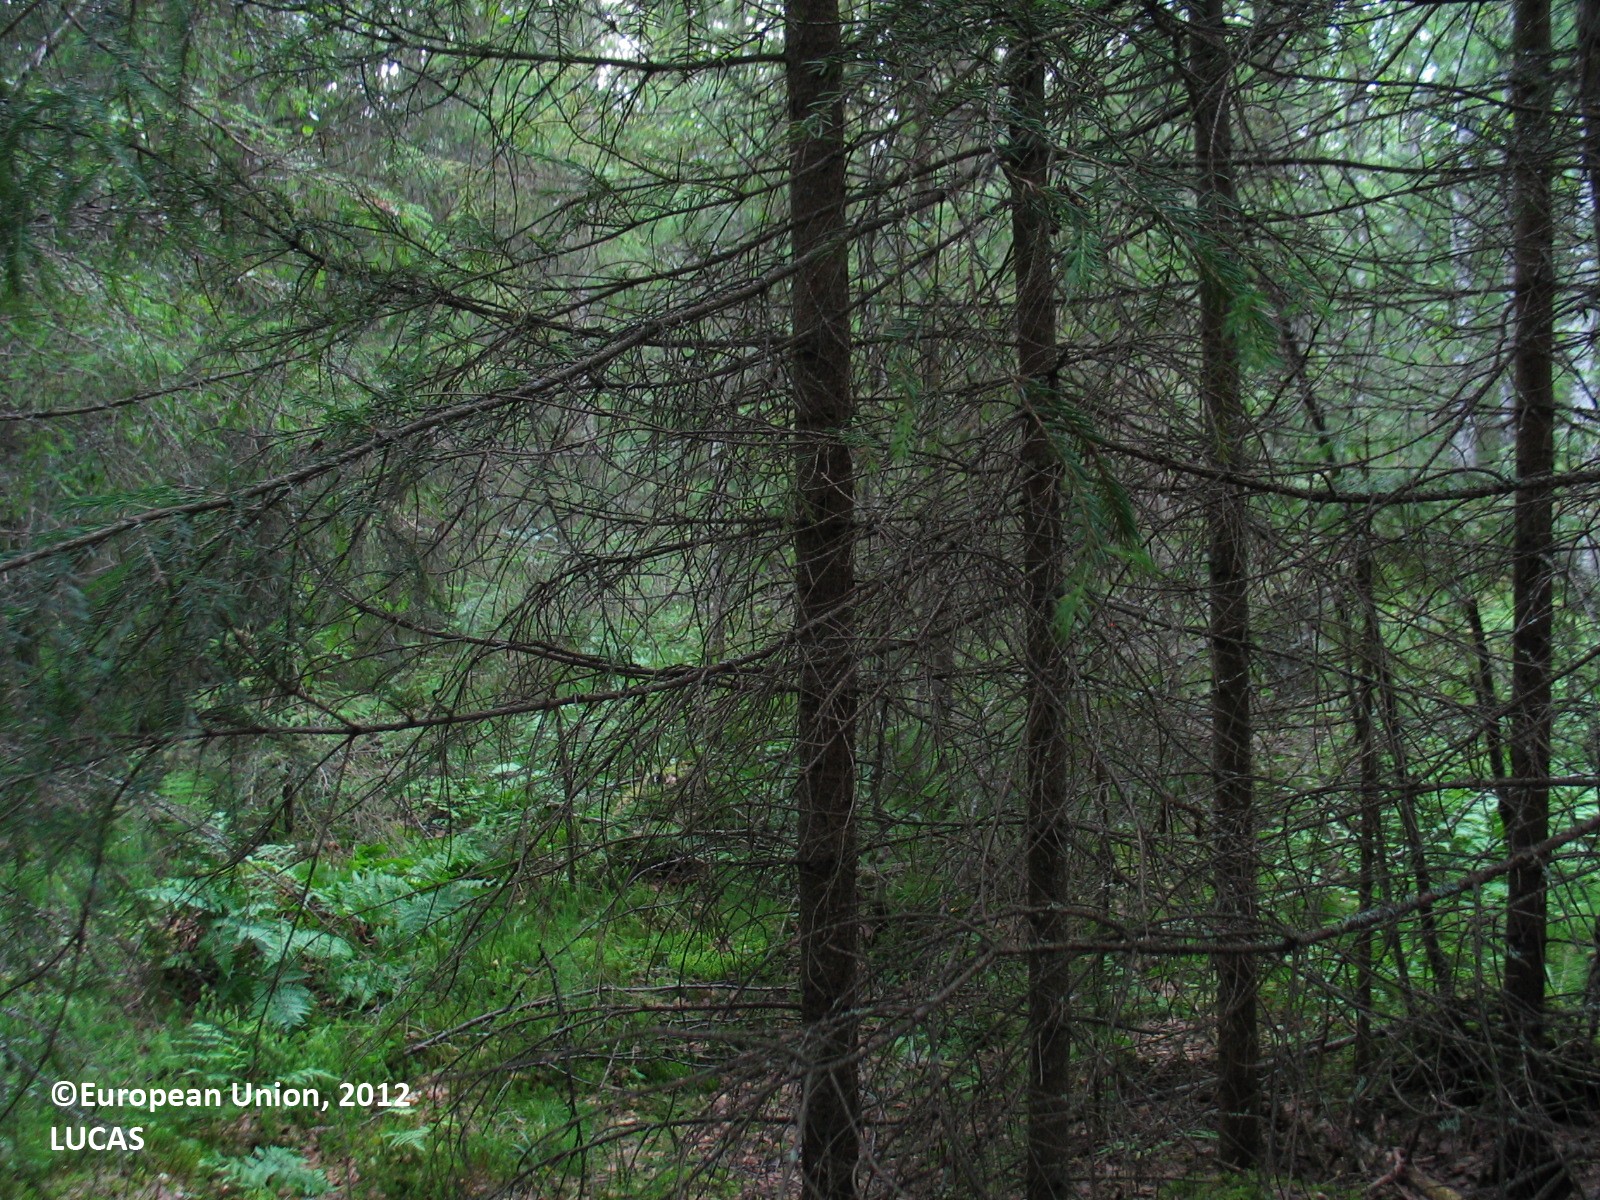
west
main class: Woodland
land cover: Other mixed woodland
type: mire and swamp forests
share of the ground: 50 - 75 %
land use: Forestry
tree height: > 5 m
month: July
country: FI
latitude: 64.5812
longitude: 26.3332
